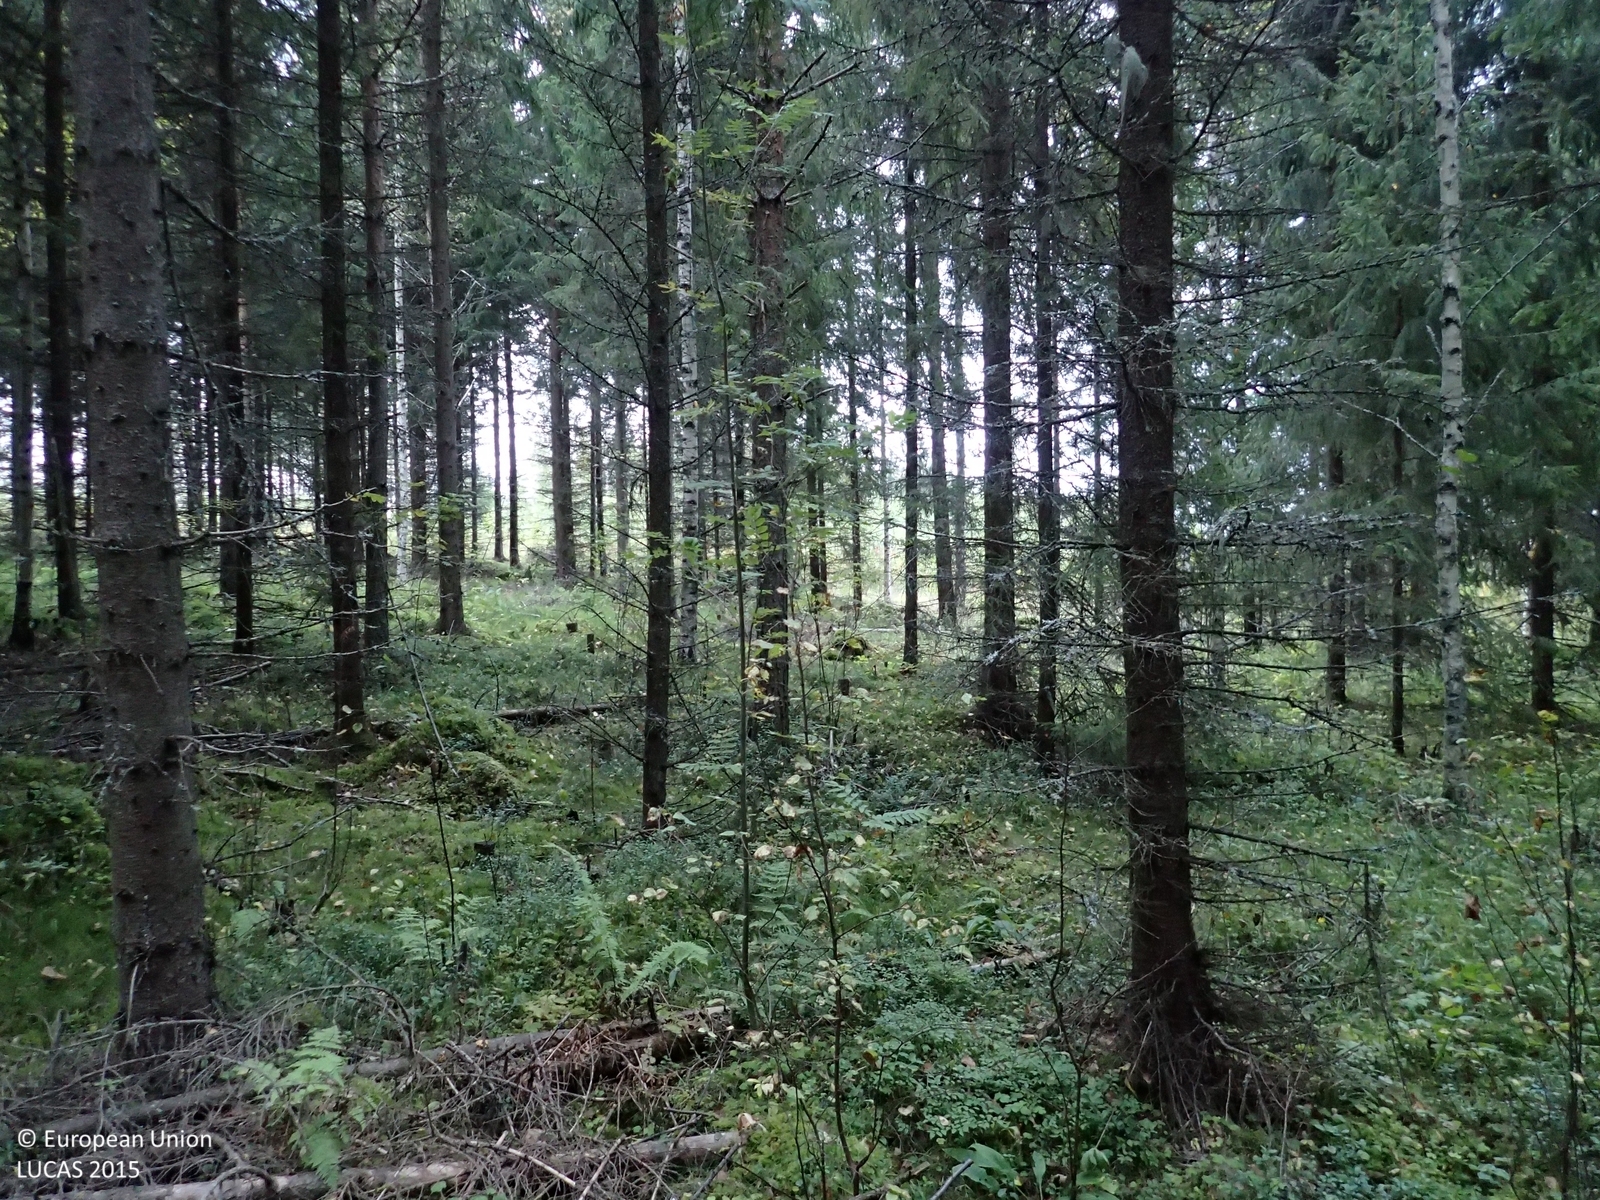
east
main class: Woodland
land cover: Spruce dominated coniferous woodland
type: boreal forest
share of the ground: > 75 %
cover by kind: coniferous forest trees 75 %, lichens and mosses 10 %, broadleaved forest trees 5 %, shrubs 5 %, herbaceous plants 5 %
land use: Forestry
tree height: > 5 m
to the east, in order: Spruce dominated coniferous woodland; Broadleaved woodland; Grassland without tree/shrub cover; Paved roads, cycling and walking lanes; Grassland without tree/shrub cover; Fences; Spruce dominated mixed woodland; Grassland with sparse tree/shrub cover
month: September
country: FI
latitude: 63.0585
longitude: 25.8421
